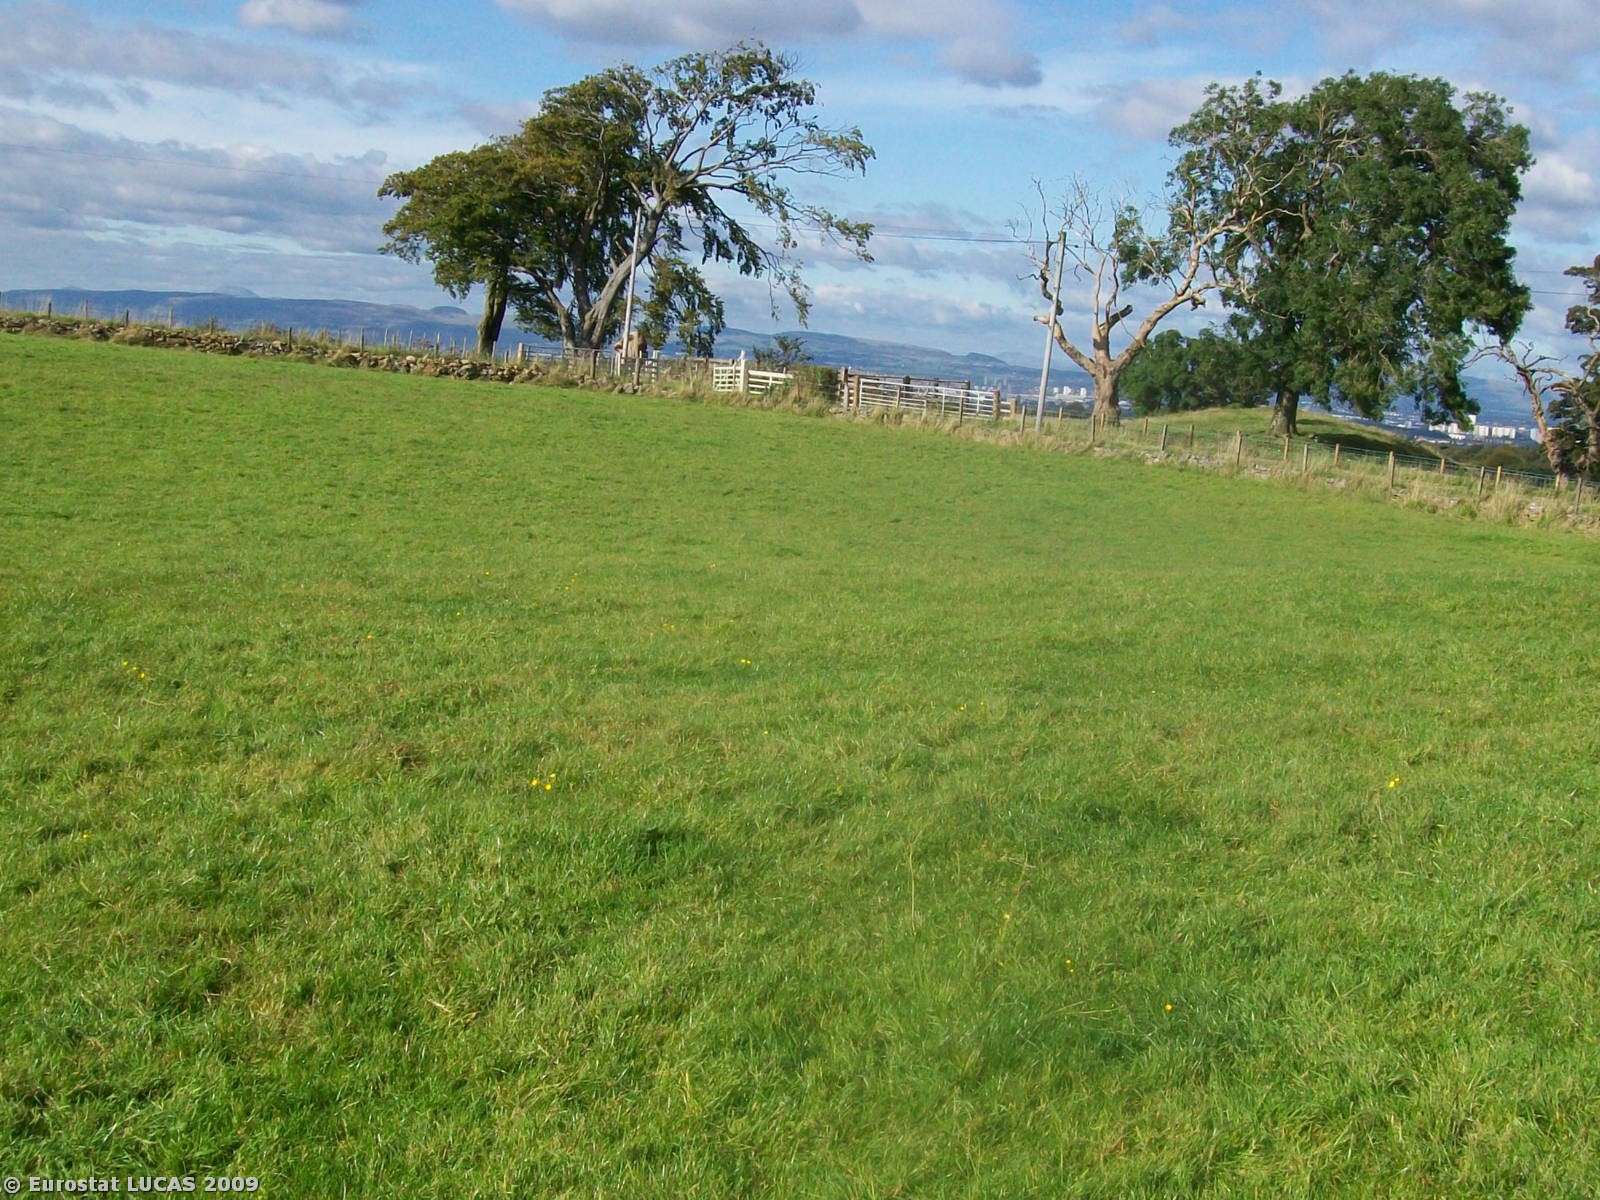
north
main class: Grassland
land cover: Grassland without tree/shrub cover
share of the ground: < 10 %
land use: Agriculture (excluding fallow land and kitchen gardens)
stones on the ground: 10 - 25 %
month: September
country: GB
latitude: 55.7761
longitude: -4.3646
